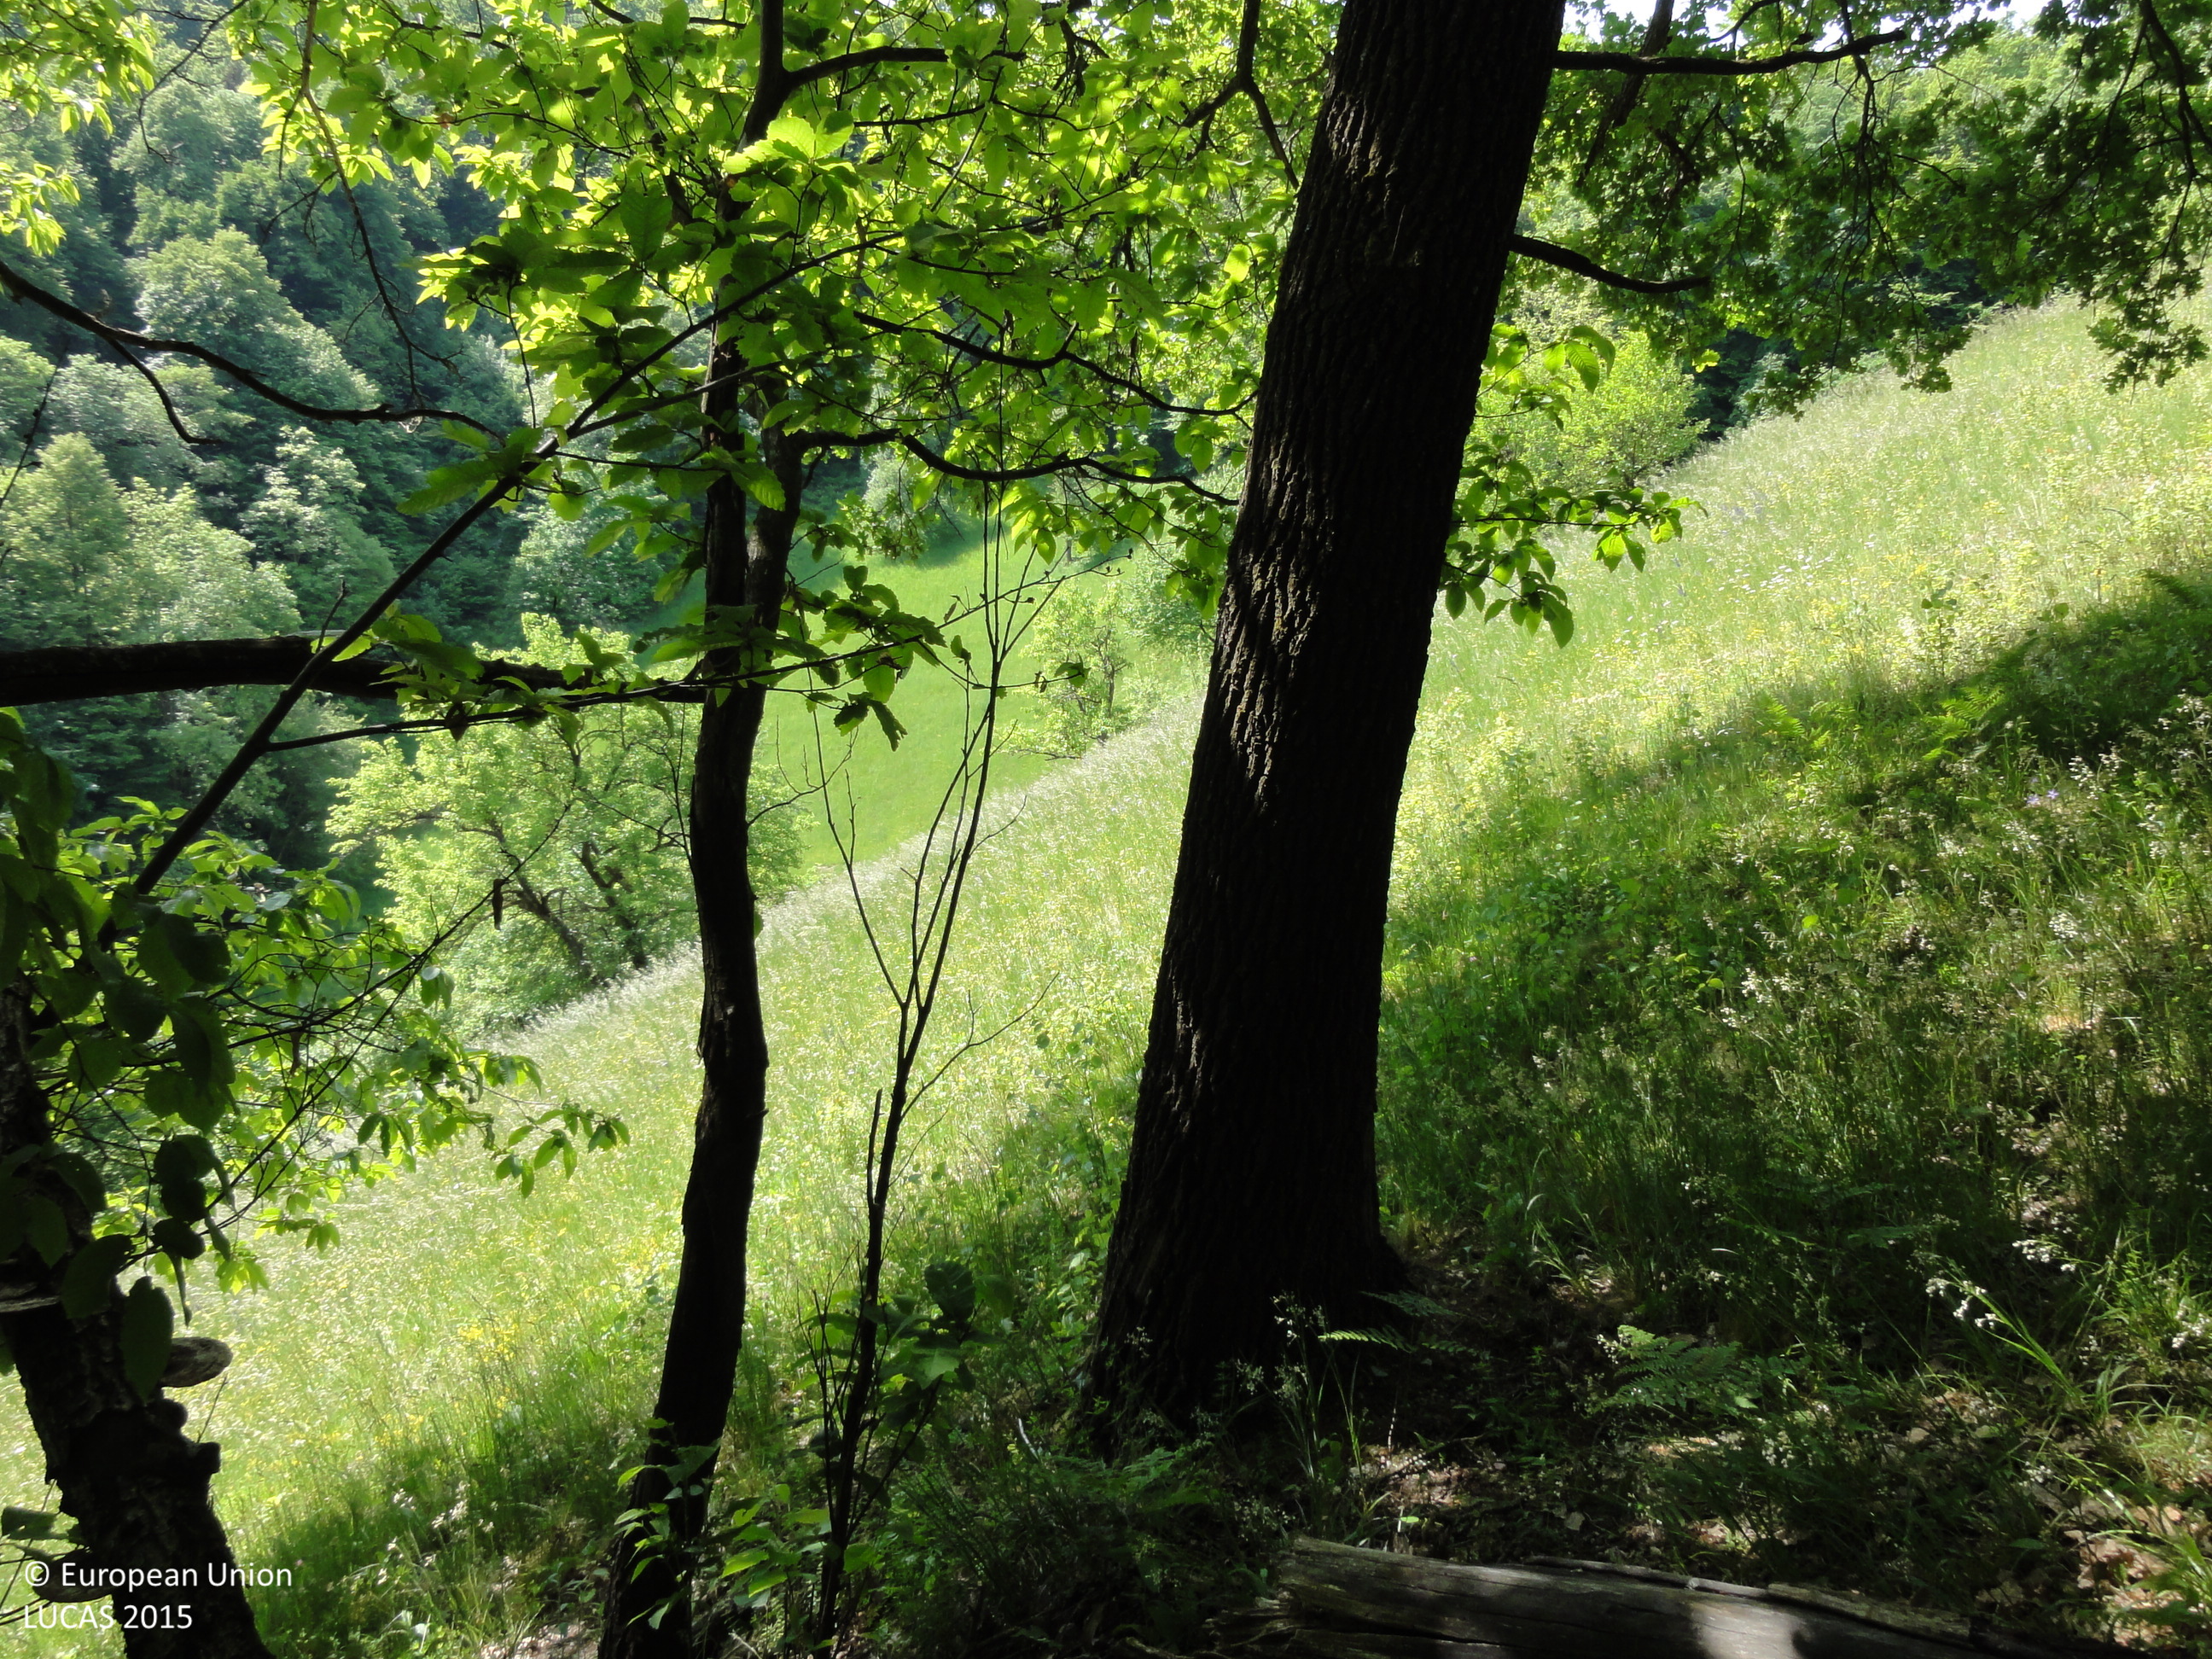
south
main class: Woodland
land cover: Broadleaved woodland
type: mesophytic deciduous forest
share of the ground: > 75 %
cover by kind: broadleaved forest trees 100 %
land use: Forestry
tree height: > 5 m
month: May
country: SI
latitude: 46.2044
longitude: 15.2465
